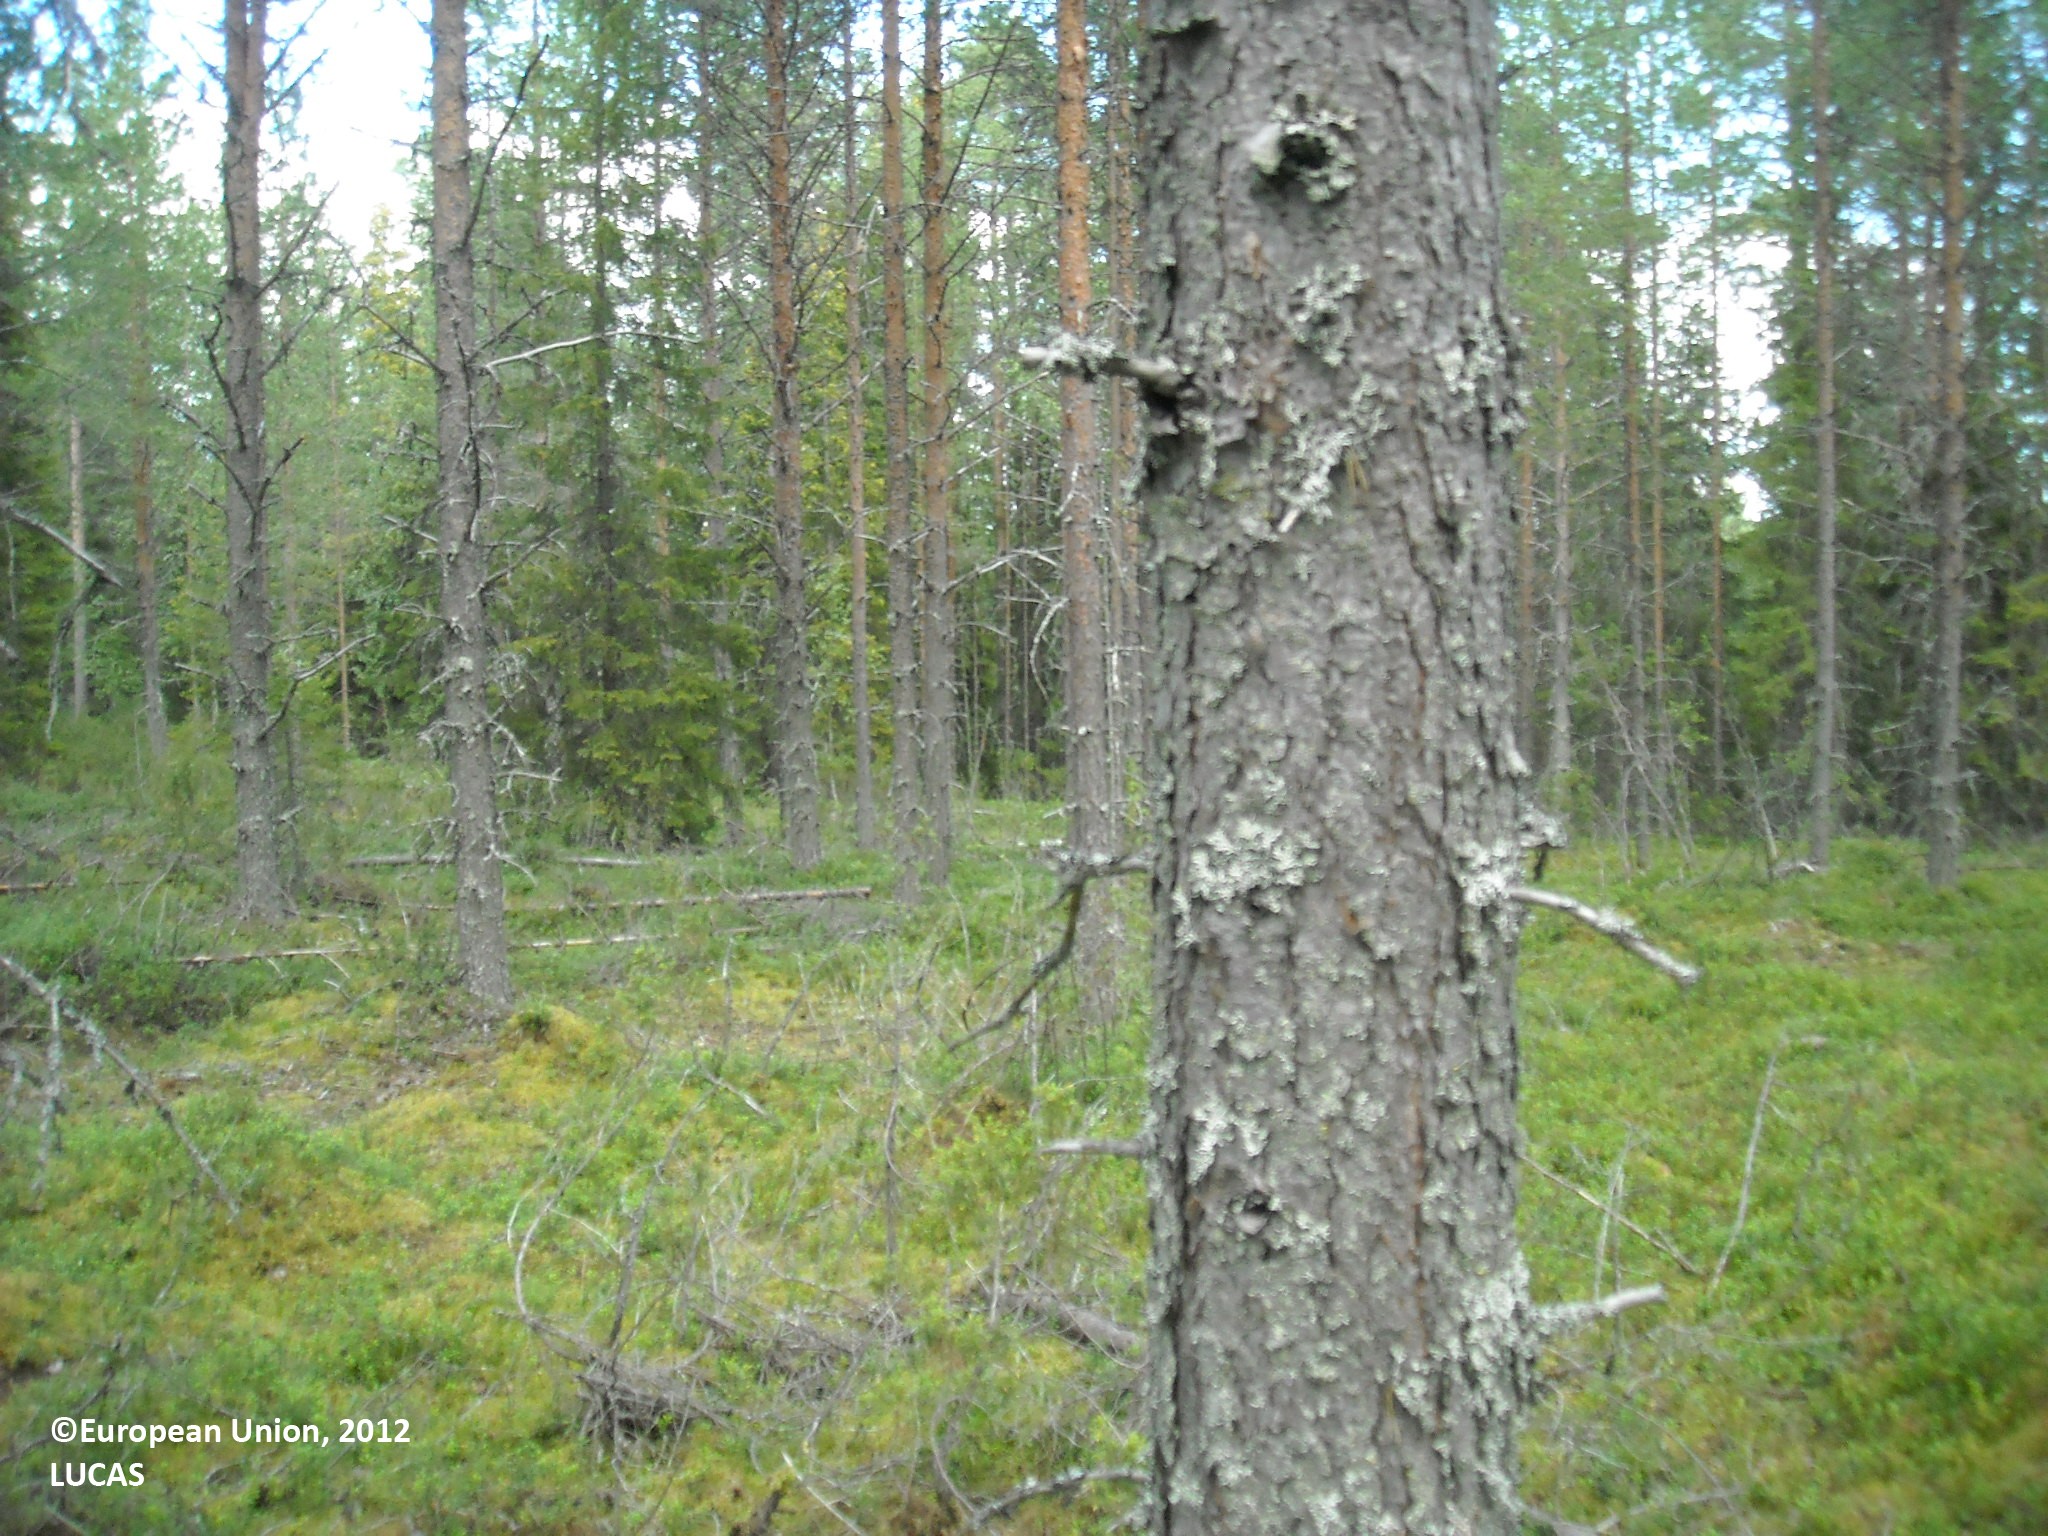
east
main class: Woodland
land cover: Pine dominated coniferous woodland
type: boreal forest
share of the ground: 50 - 75 %
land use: Forestry
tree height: > 5 m
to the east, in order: Pine dominated coniferous woodland; Pine dominated mixed woodland; Other mixed woodland; Inland running water; Broadleaved woodland; Inland running water
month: August
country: FI
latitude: 65.3906
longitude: 27.8093
